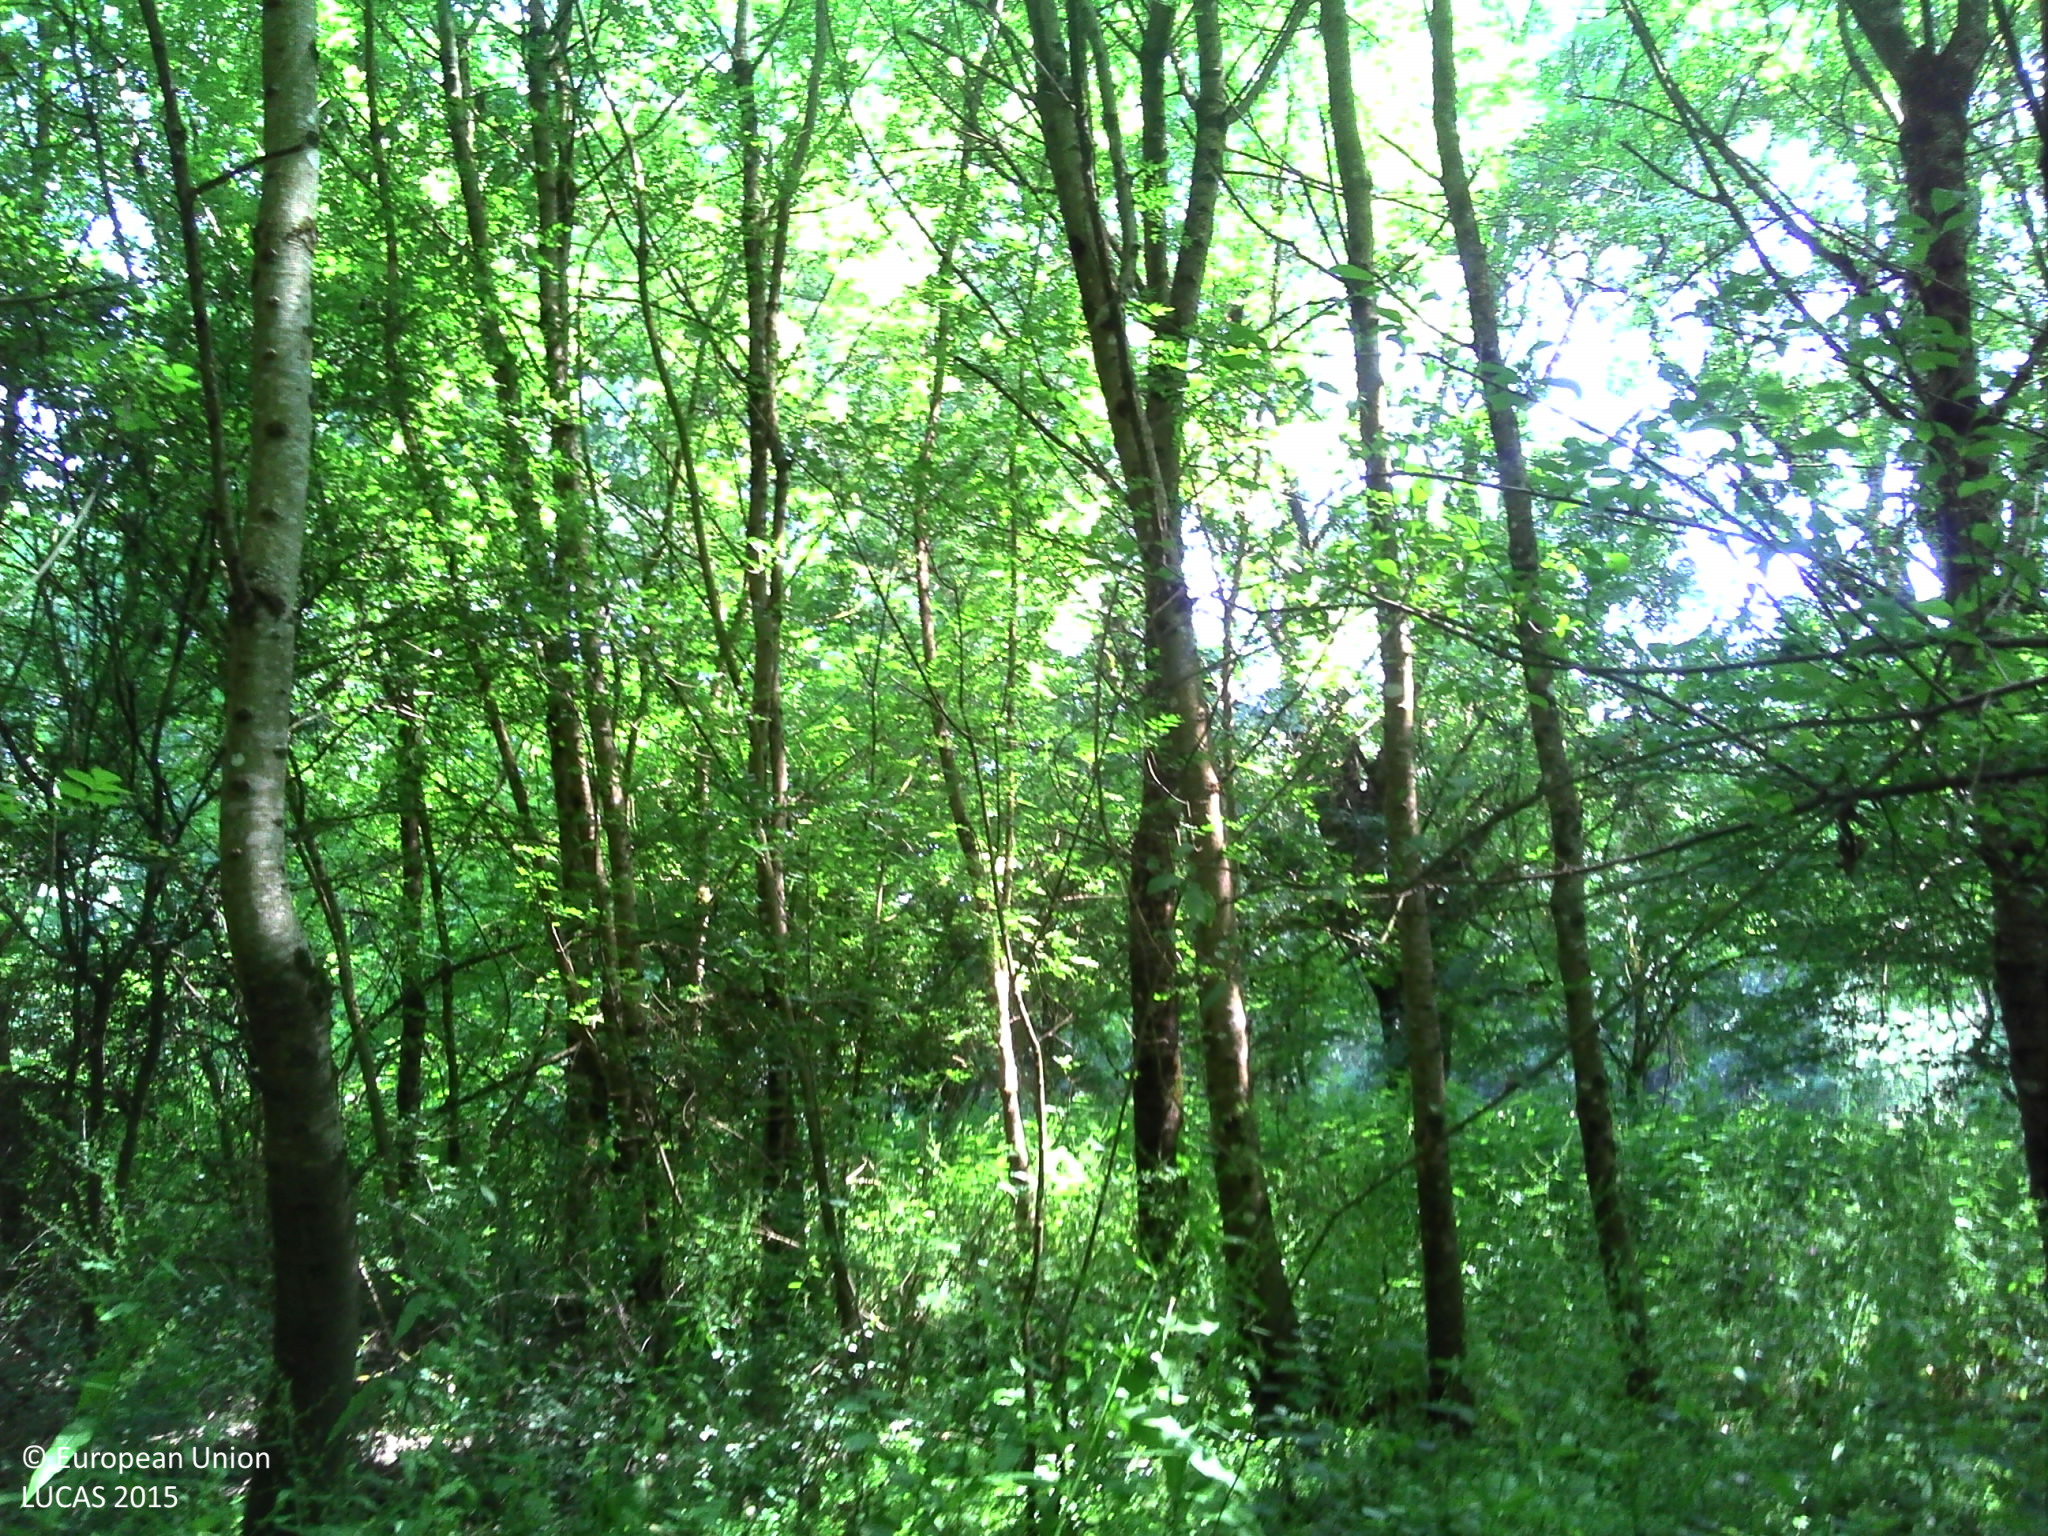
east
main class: Woodland
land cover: Broadleaved woodland
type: floodplain forest
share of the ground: > 75 %
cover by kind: broadleaved forest trees 95 %, herbaceous plants 5 %
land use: Semi-natural and natural areas not in use
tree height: > 5 m
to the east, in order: Broadleaved woodland; Fences; Grassland without tree/shrub cover; Fences; Broadleaved woodland; Rivers and streams; Broadleaved woodland; Grass margins; Vineyards
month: June
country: FR
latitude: 47.1374
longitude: -1.4186
